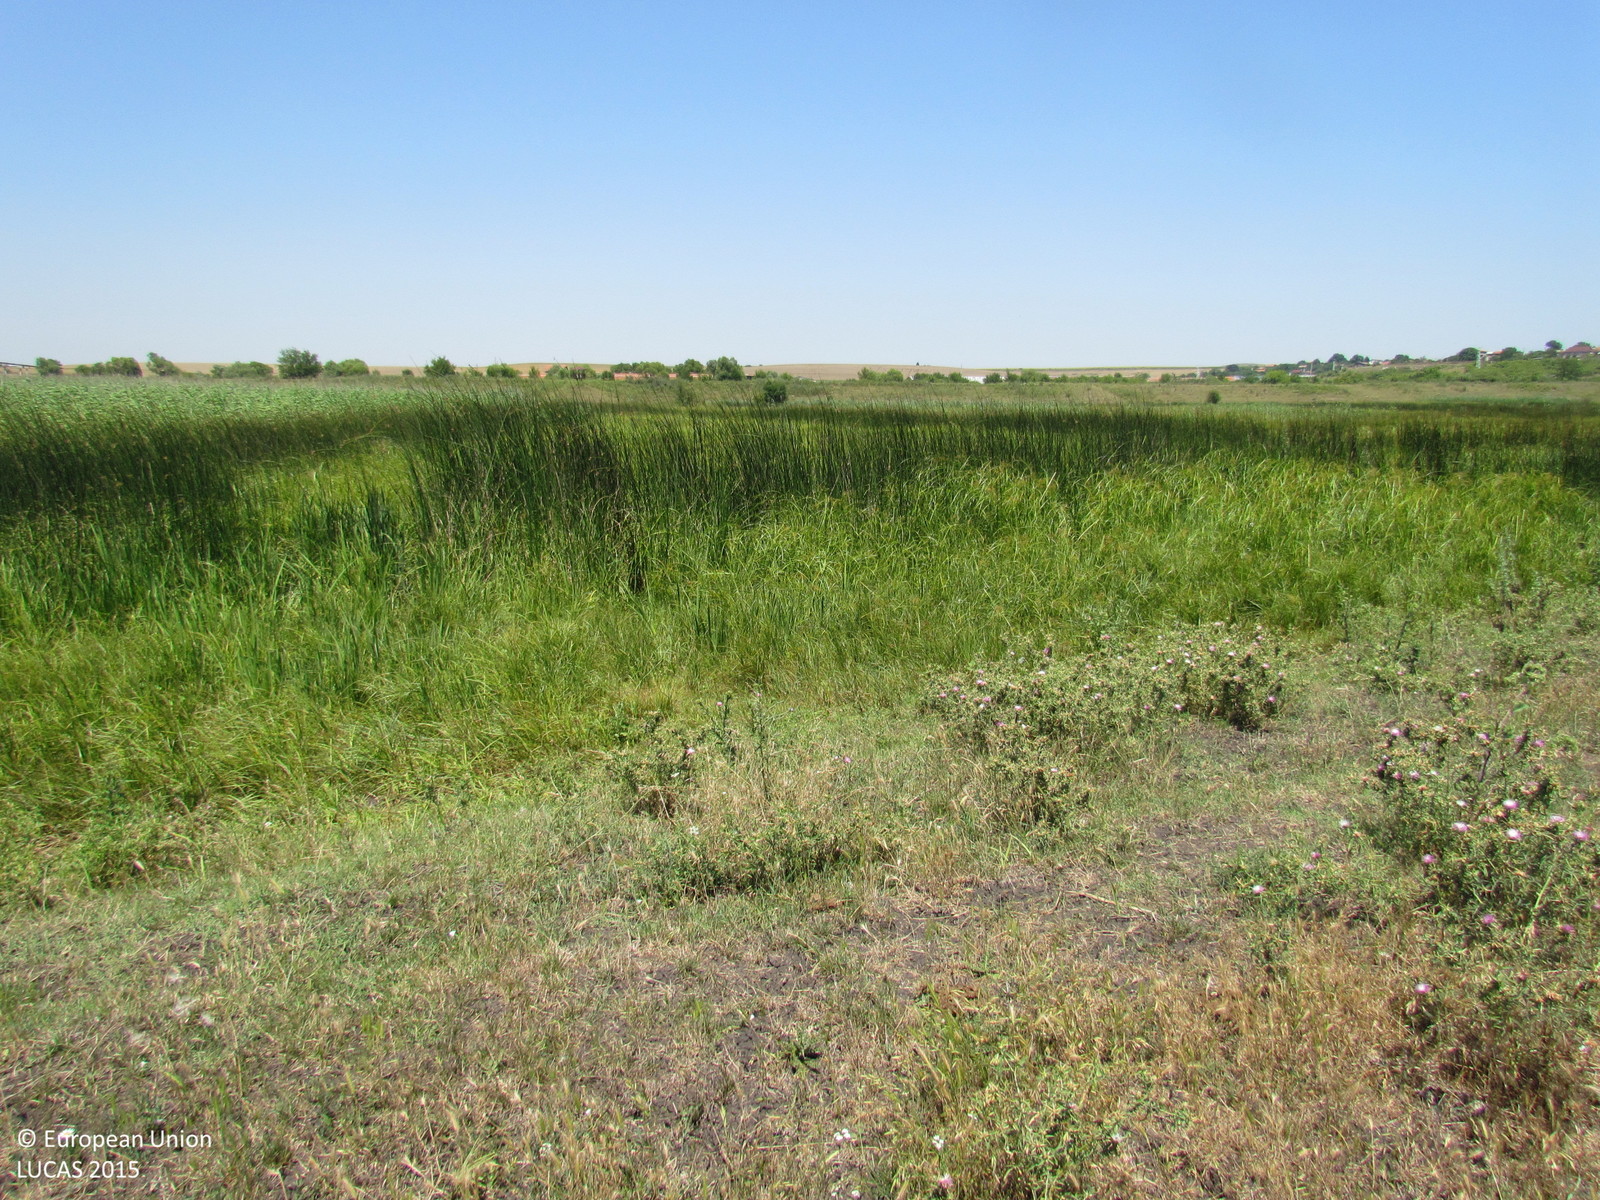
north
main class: Grassland
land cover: Spontaneously vegetated surfaces
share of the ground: > 75 %
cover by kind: herbaceous plants 100 %
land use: Fallow land
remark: Temporary flooded
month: July
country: BG
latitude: 42.4044
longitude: 27.3035
